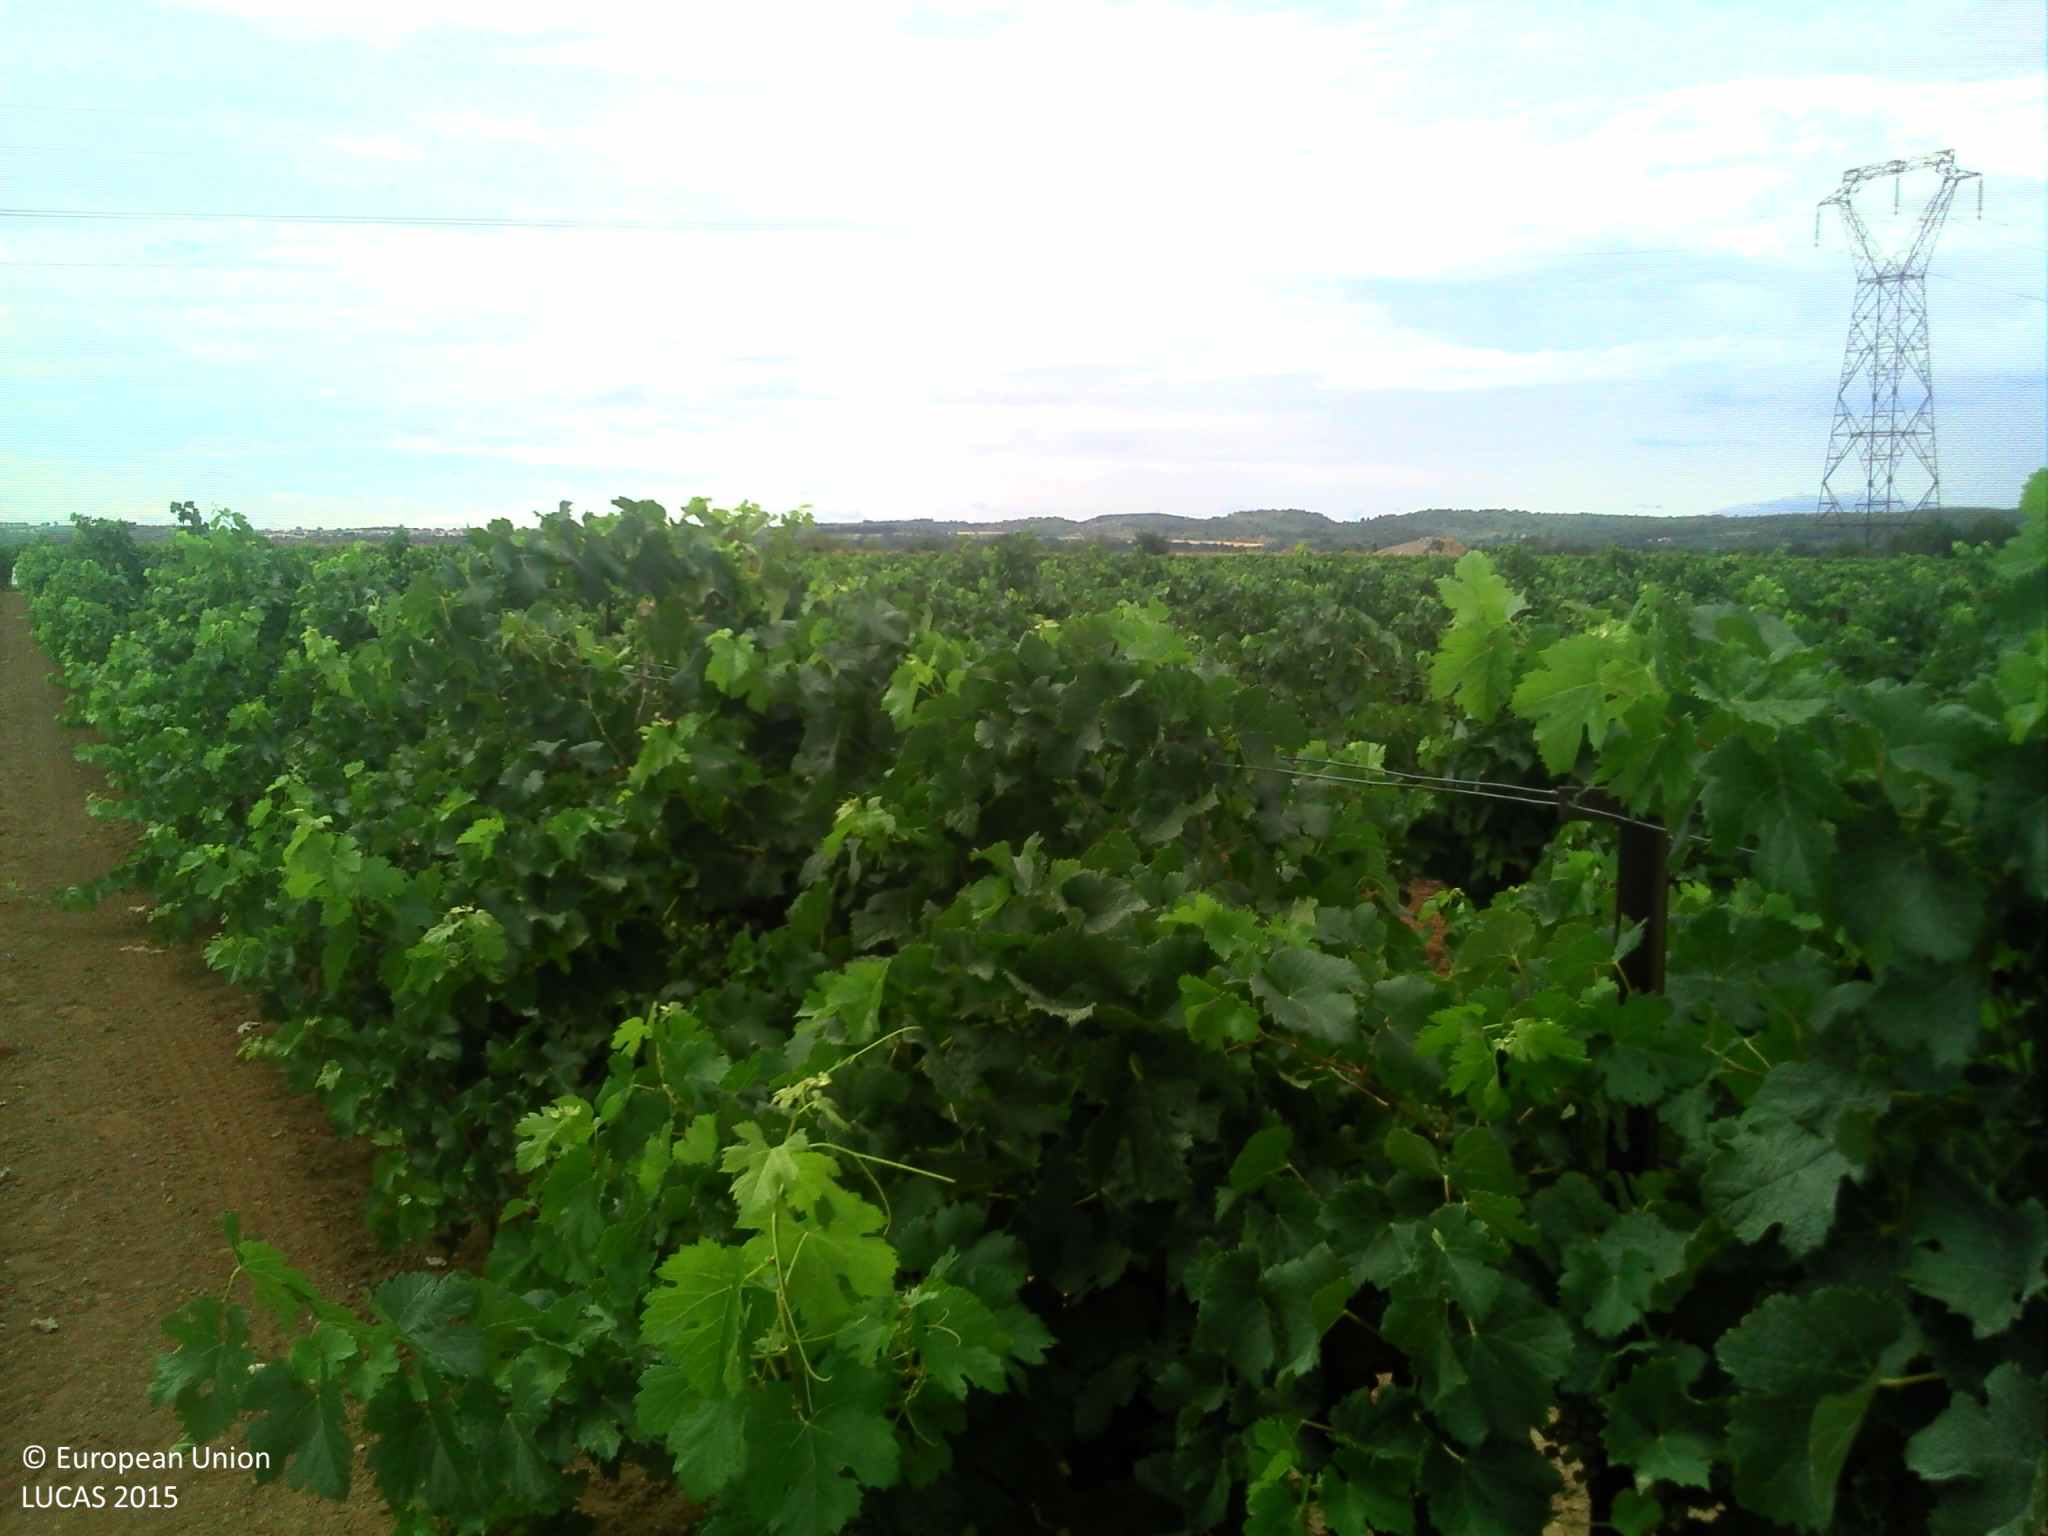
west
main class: Cropland
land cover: Vineyards
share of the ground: 25 - 50 %
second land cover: Other bare soil
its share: > 75 %
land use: Agriculture (excluding fallow land and kitchen gardens)
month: July
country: FR
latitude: 43.4184
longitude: 3.1542
